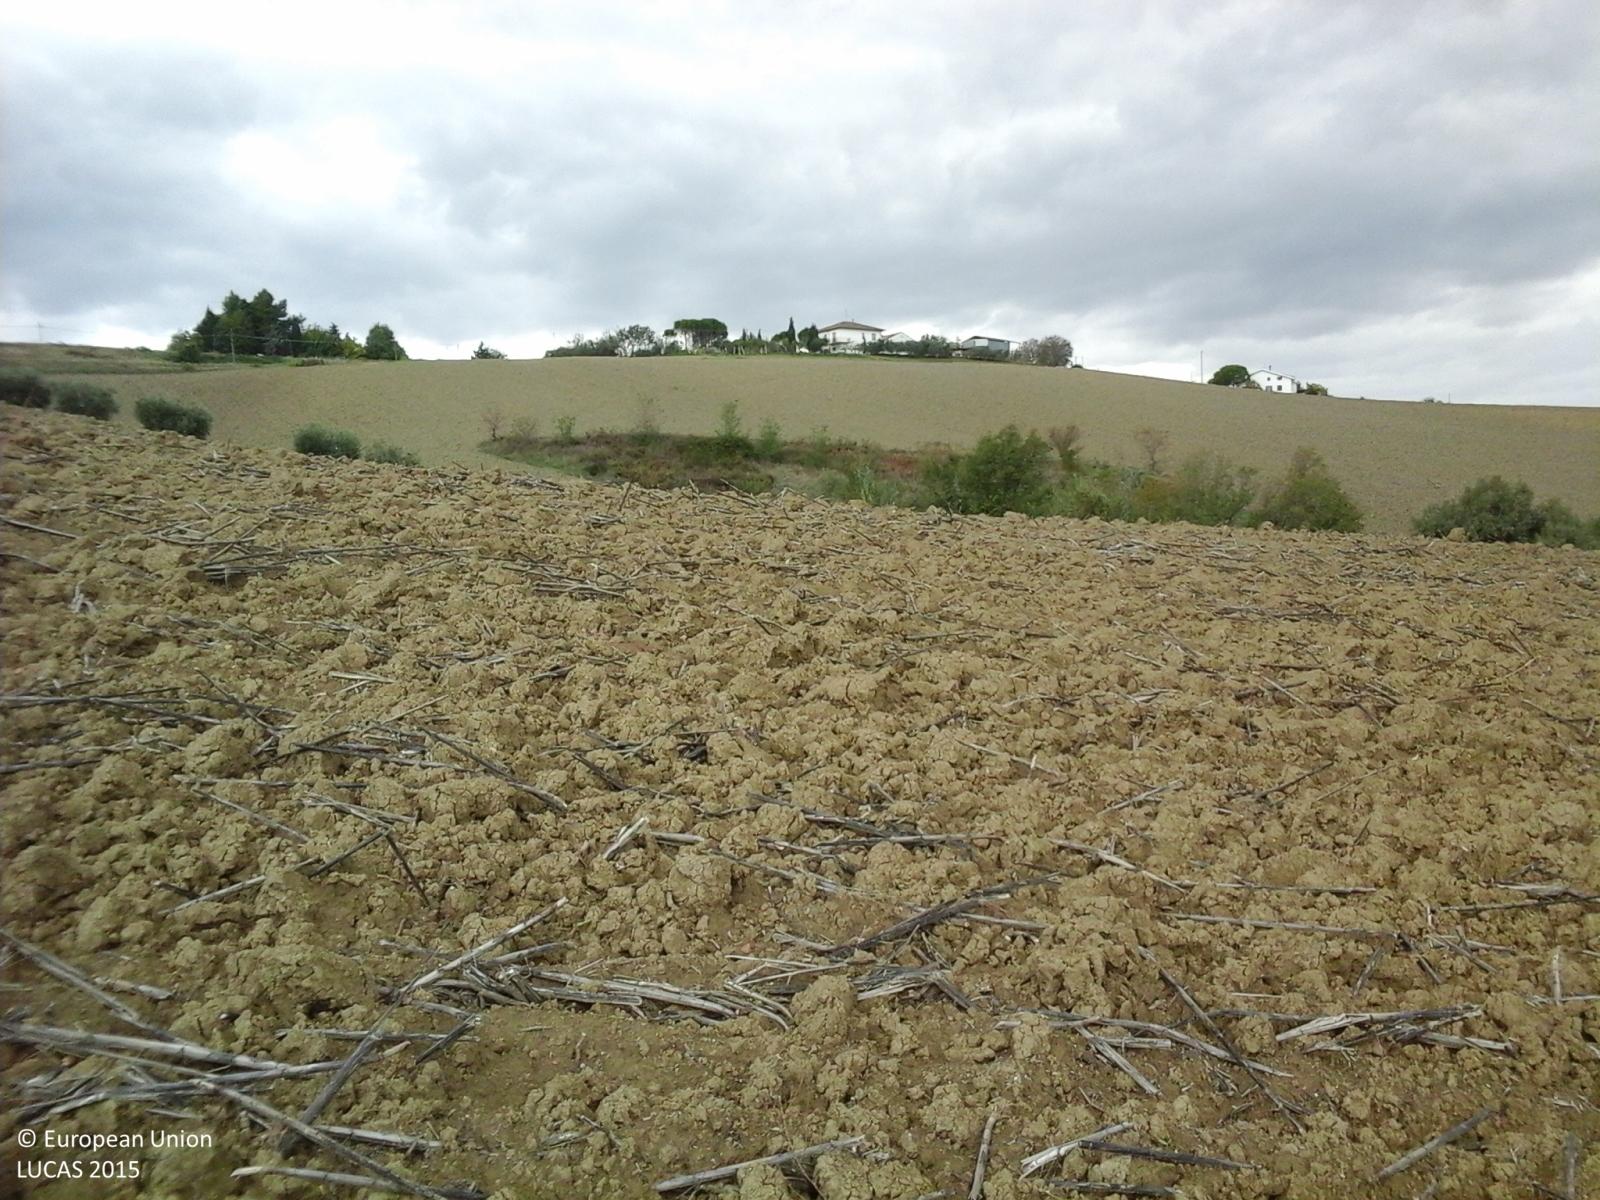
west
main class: Cropland
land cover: Sunflower
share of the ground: < 10 %
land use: Agriculture (excluding fallow land and kitchen gardens)
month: October
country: IT
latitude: 43.5438
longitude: 13.1729
